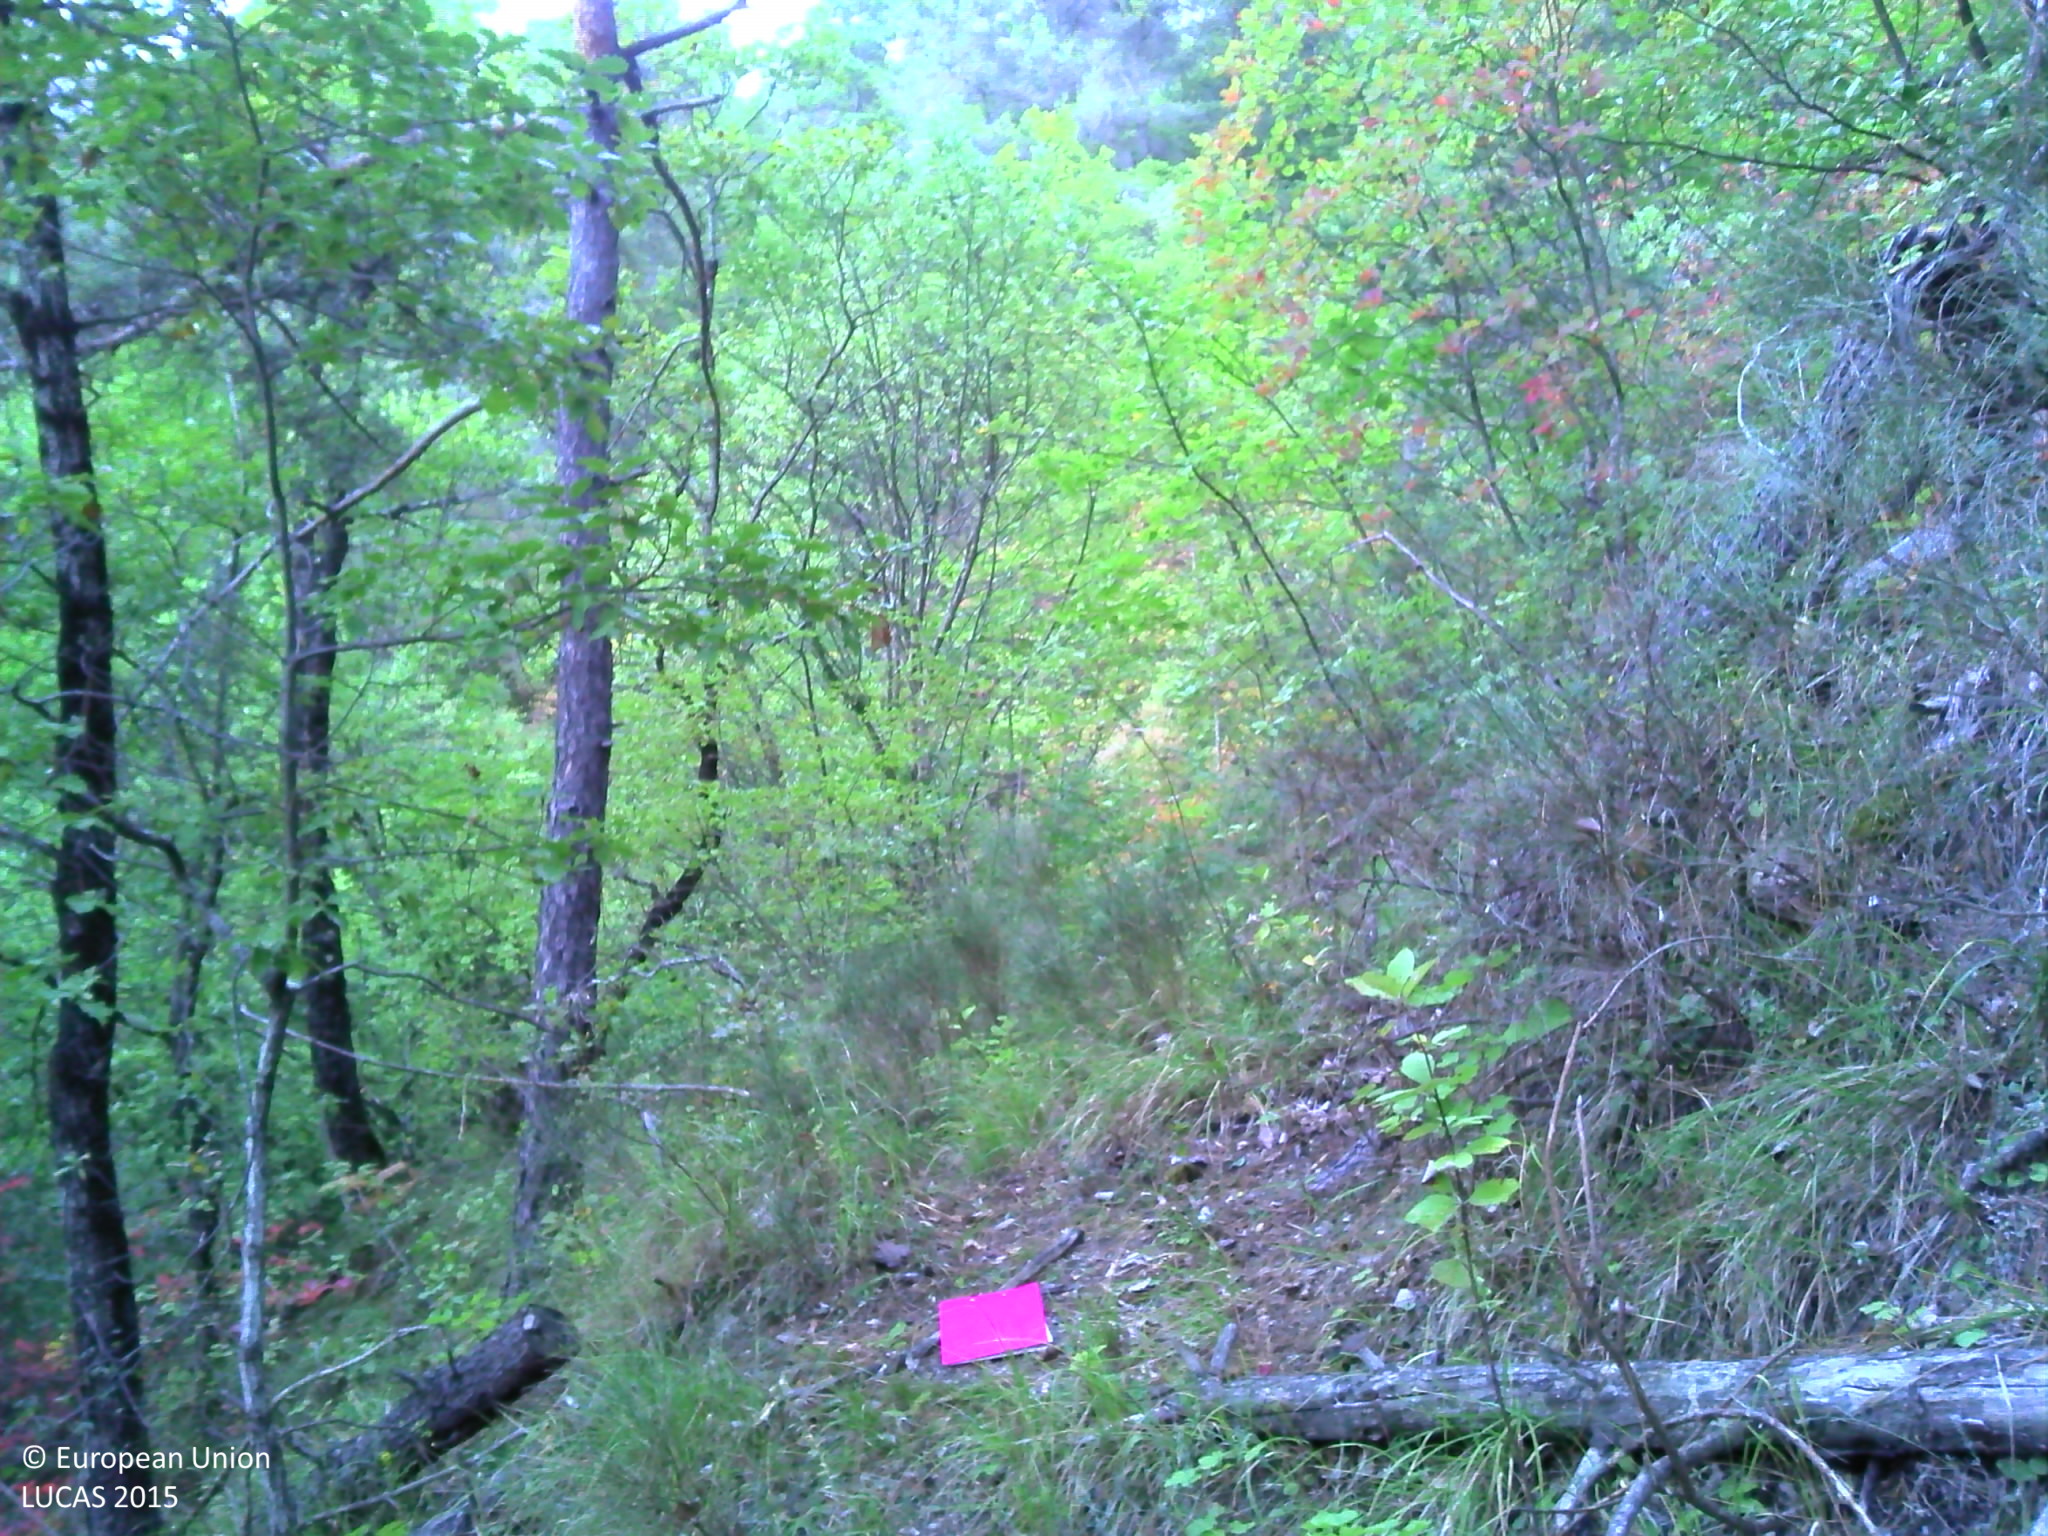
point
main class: Woodland
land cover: Pine dominated mixed woodland
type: coniferous forest of the mediterranean region
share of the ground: 50 - 75 %
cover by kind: coniferous forest trees 40 %, herbaceous plants 30 %, broadleaved forest trees 20 %, shrubs 5 %, lichens and mosses 5 %
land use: Forestry
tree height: > 5 m
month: September
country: FR
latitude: 43.8770
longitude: 7.1070
